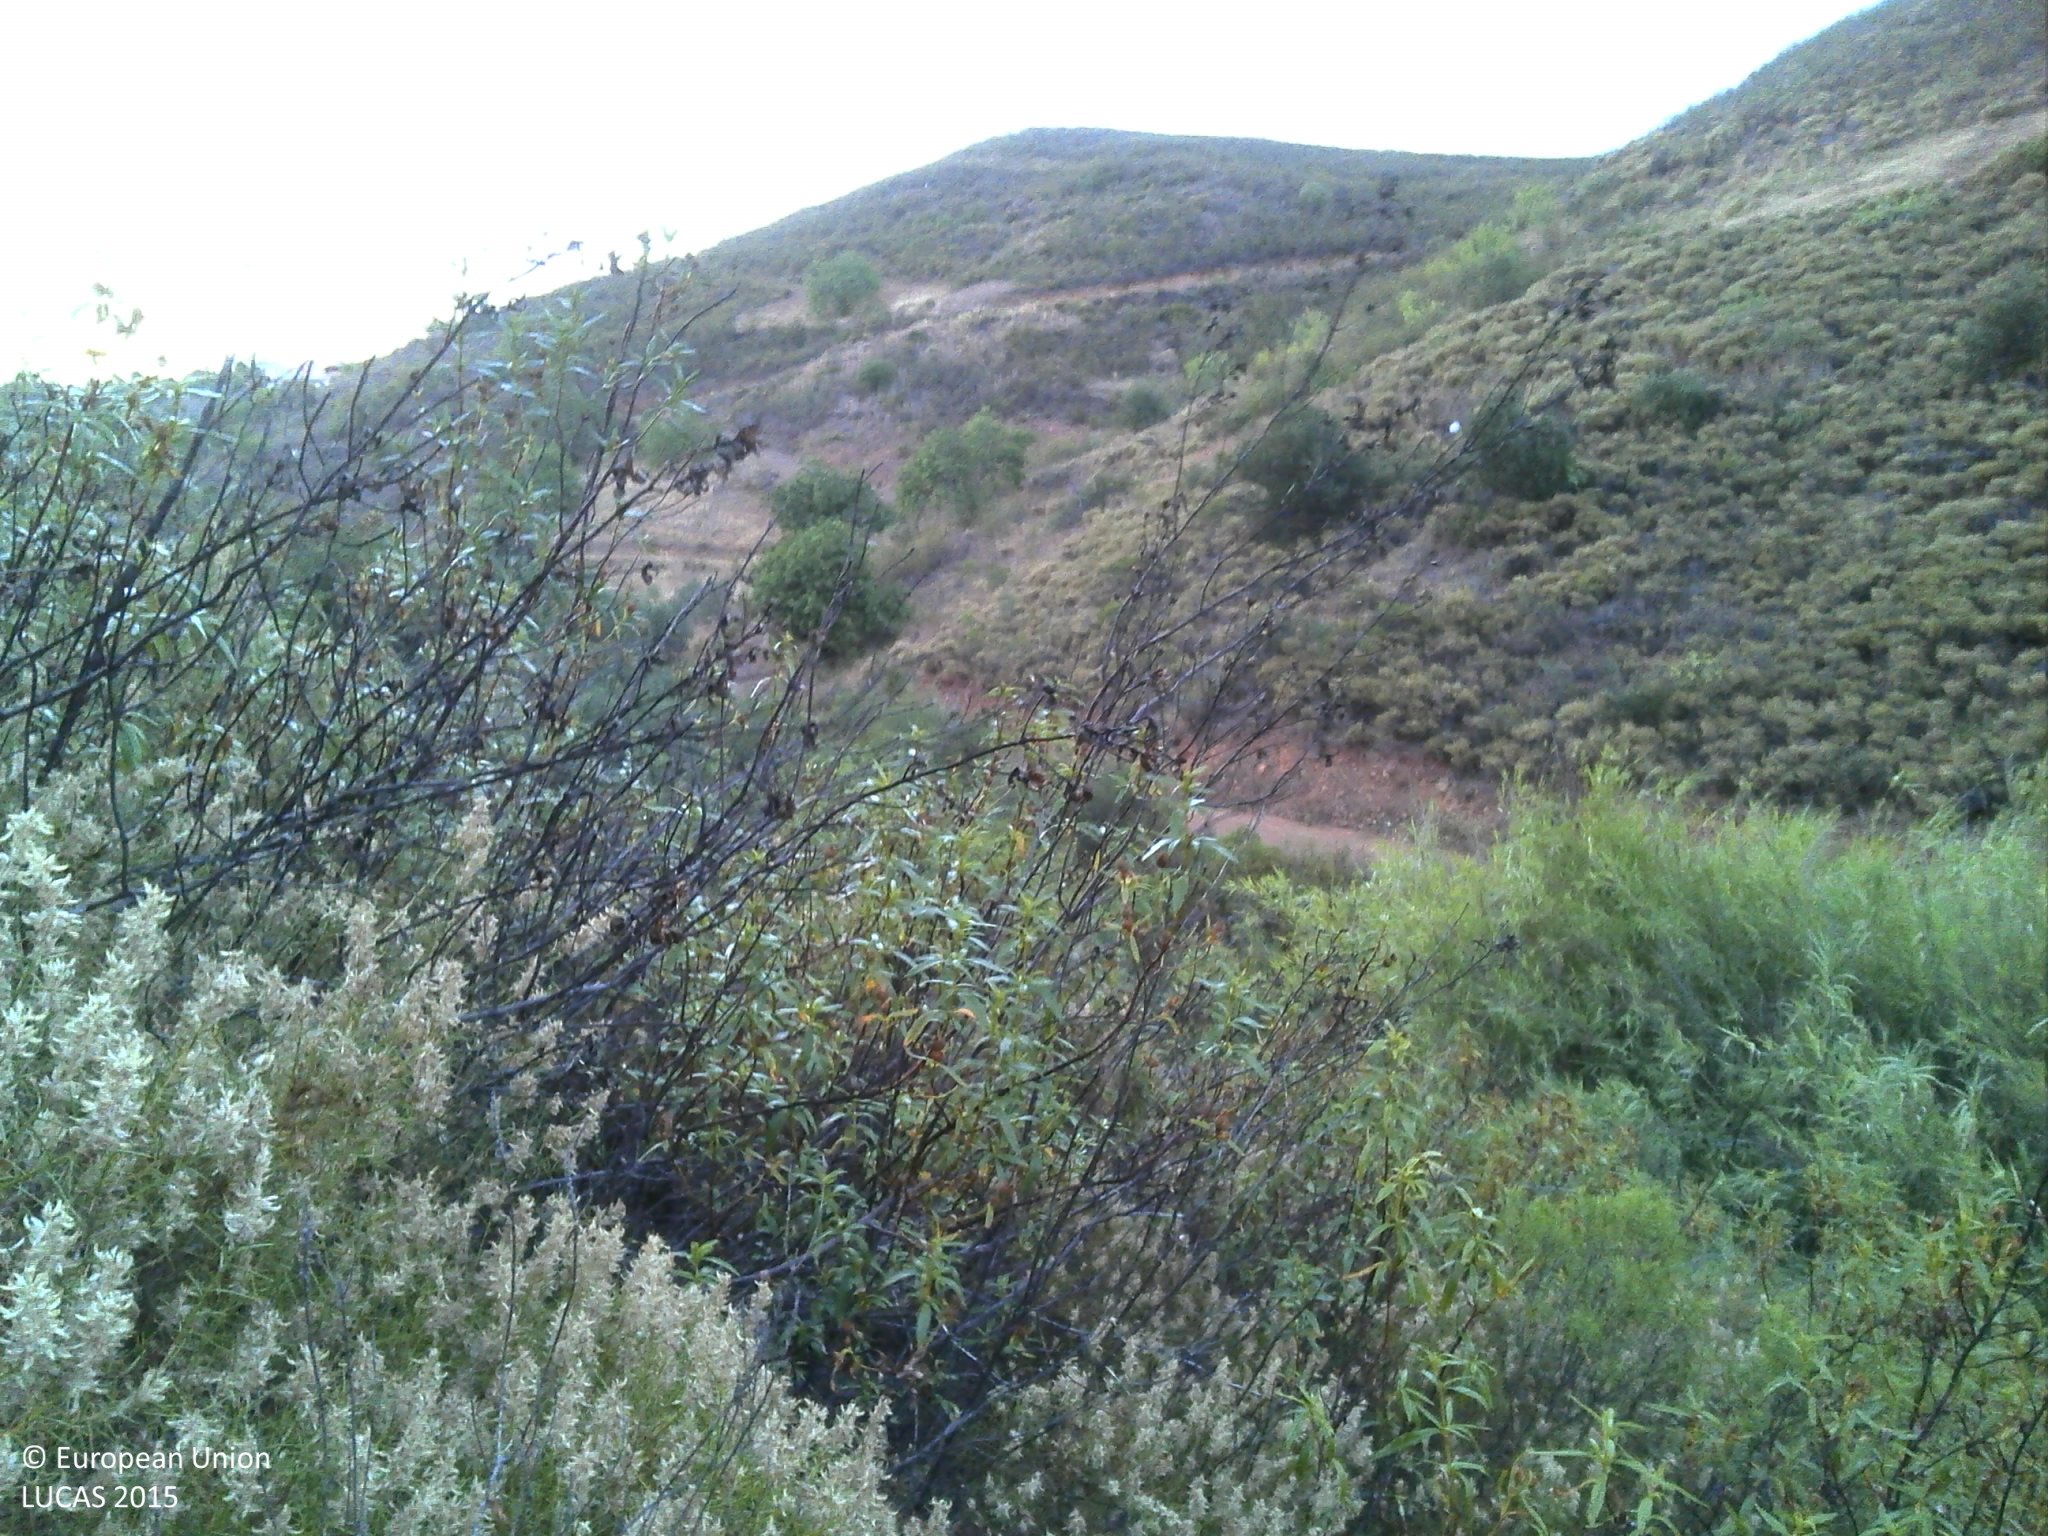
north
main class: Shrubland
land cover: Shrubland with sparse tree cover
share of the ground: > 75 %
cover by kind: shrubs 95 %, broadleaved forest trees 5 %
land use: Abandoned areas
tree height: < 5 m
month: June
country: PT
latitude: 37.1691
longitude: -7.6763
